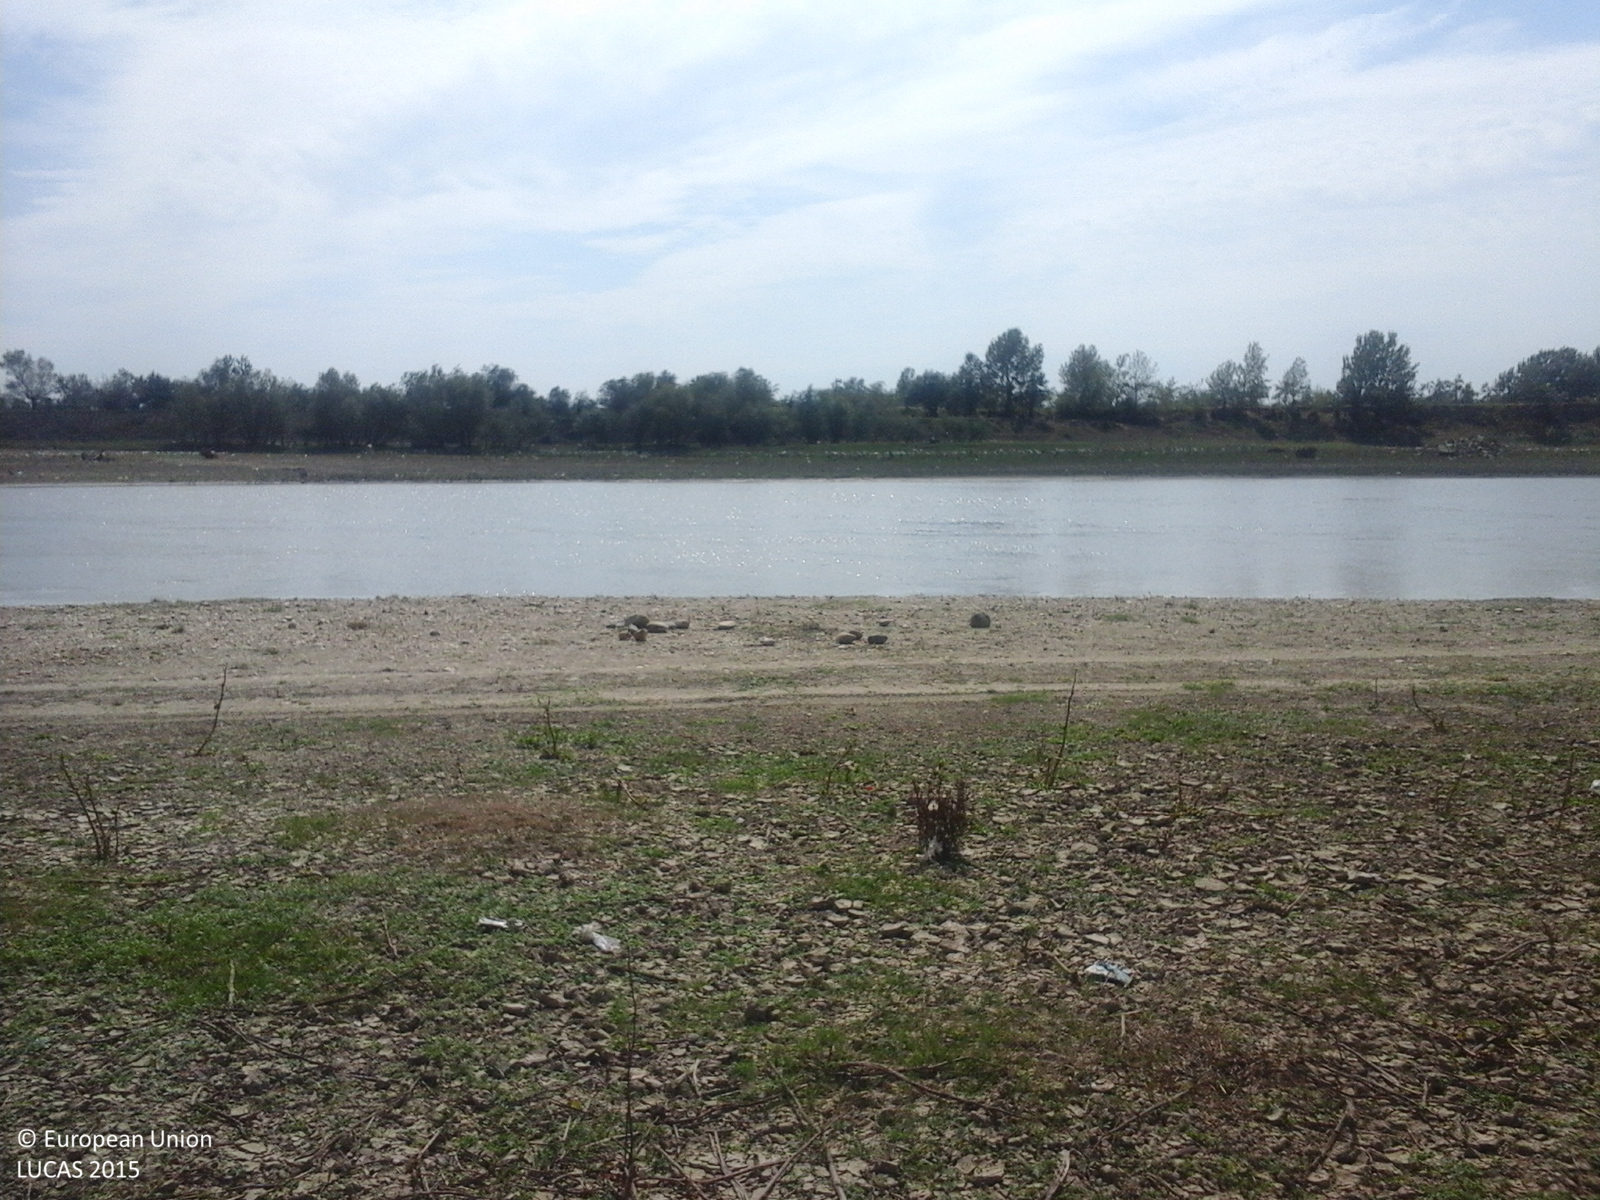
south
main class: Grassland
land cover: Spontaneously vegetated surfaces
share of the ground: > 75 %
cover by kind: herbaceous plants 70 %, consolidated bare surface 30 %
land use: Fallow land
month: August
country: RO
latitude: 46.1271
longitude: 21.5156
